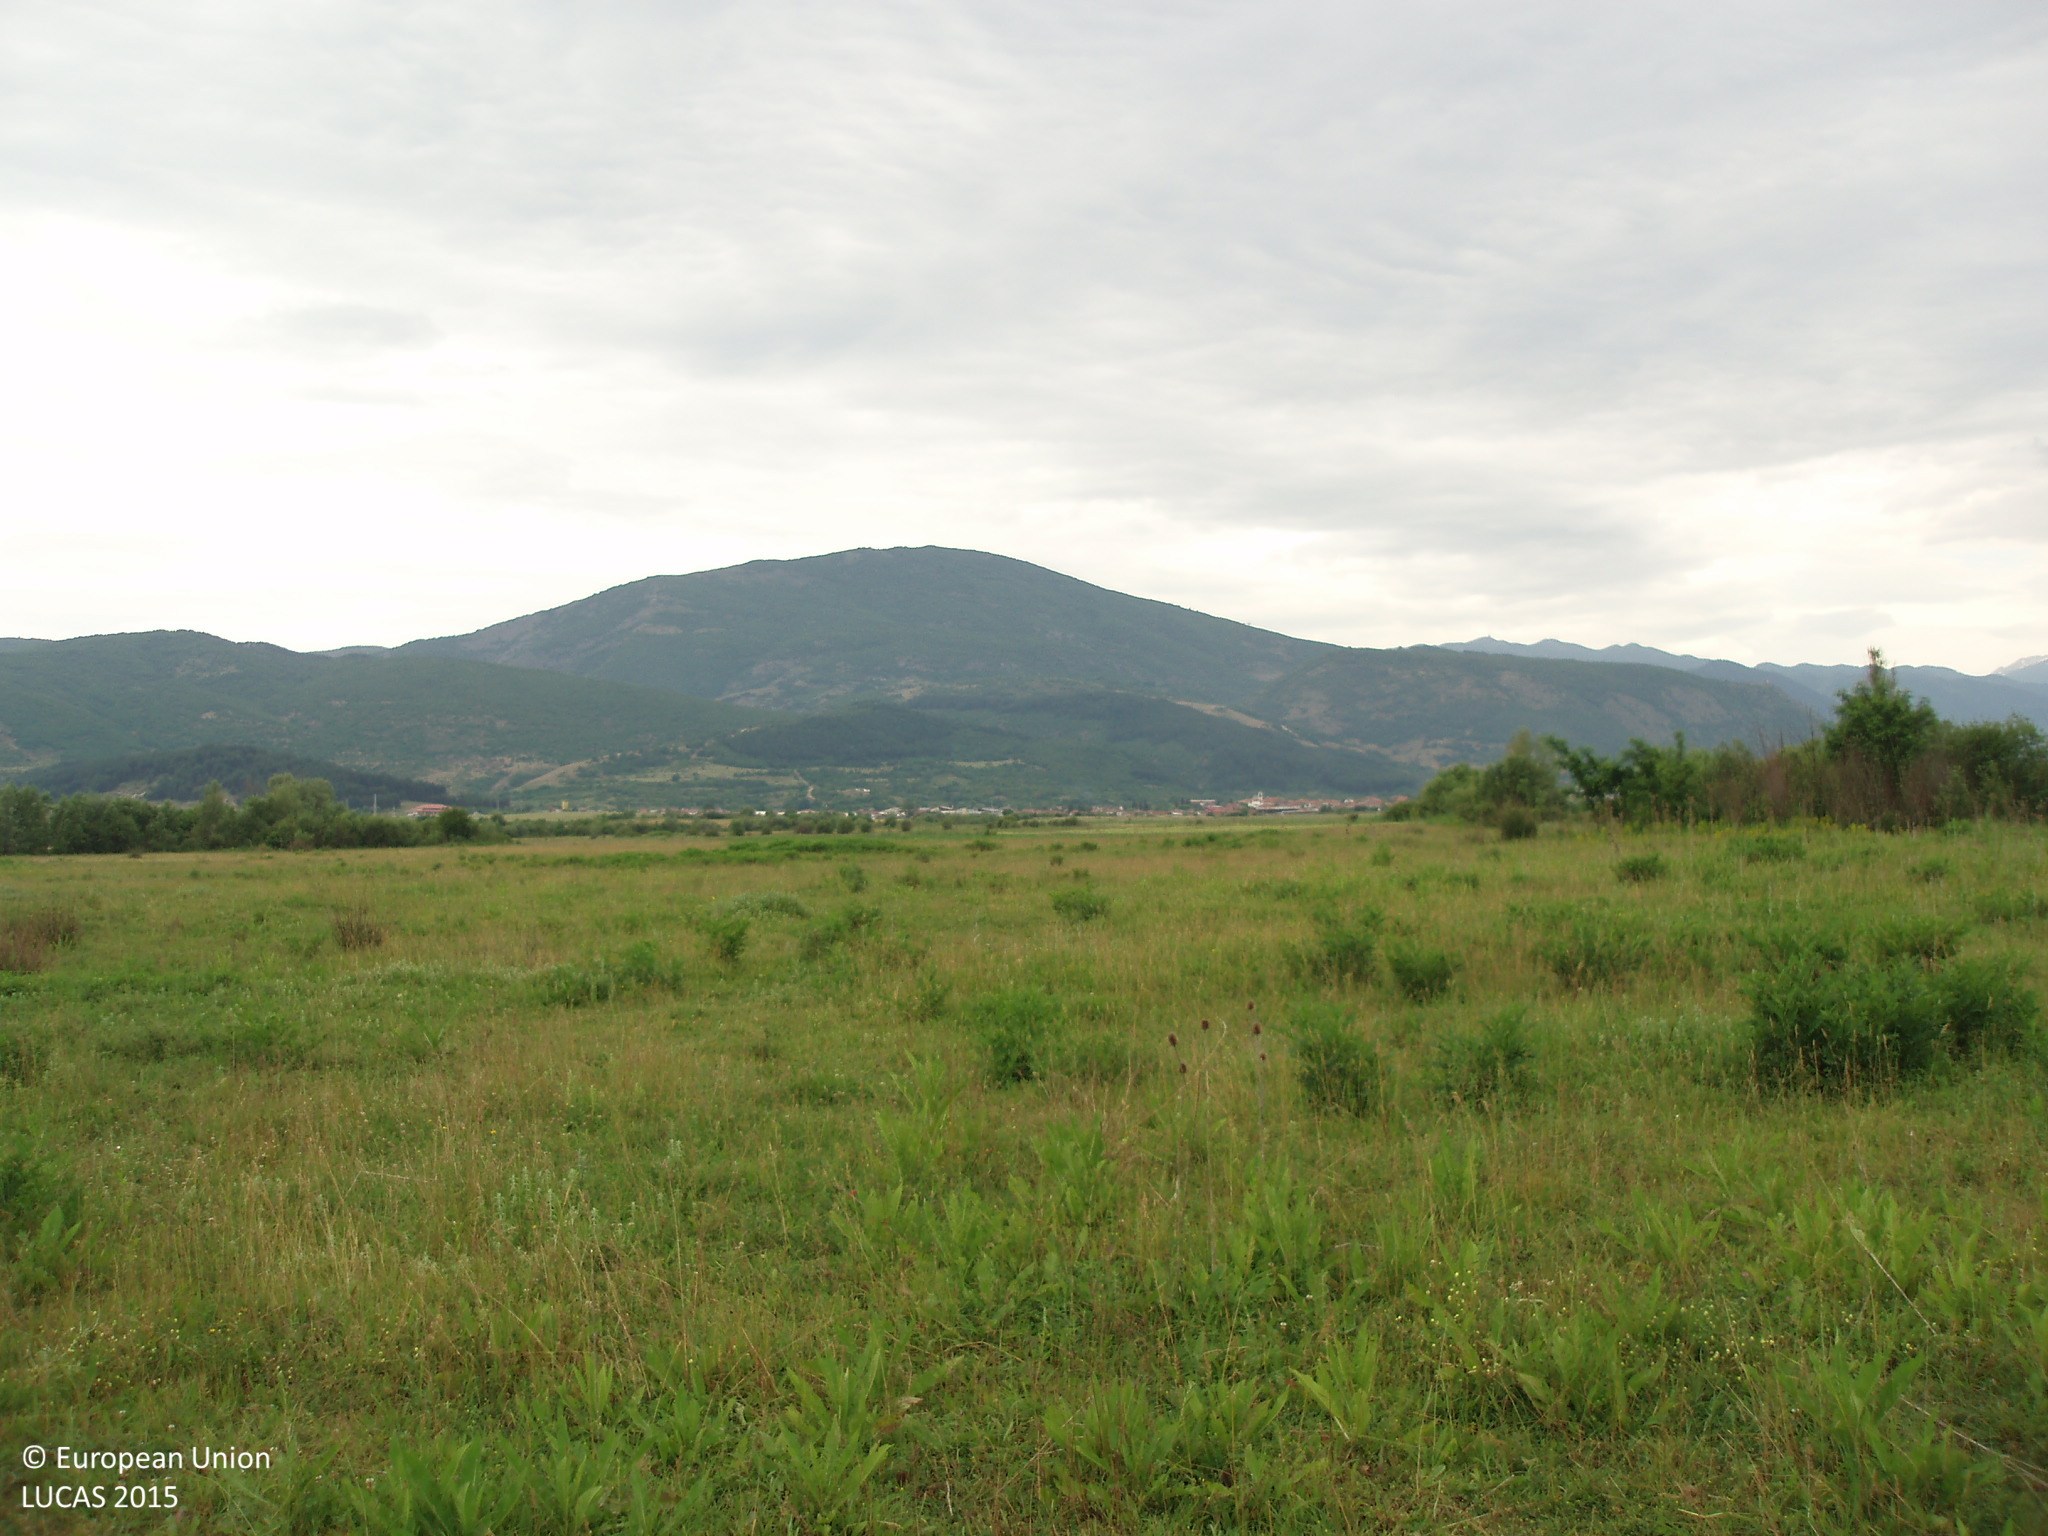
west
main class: Grassland
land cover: Grassland without tree/shrub cover
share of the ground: > 75 %
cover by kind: herbaceous plants 100 %
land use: Agriculture (excluding fallow land and kitchen gardens)
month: June
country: BG
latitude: 41.5184
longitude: 23.8212
